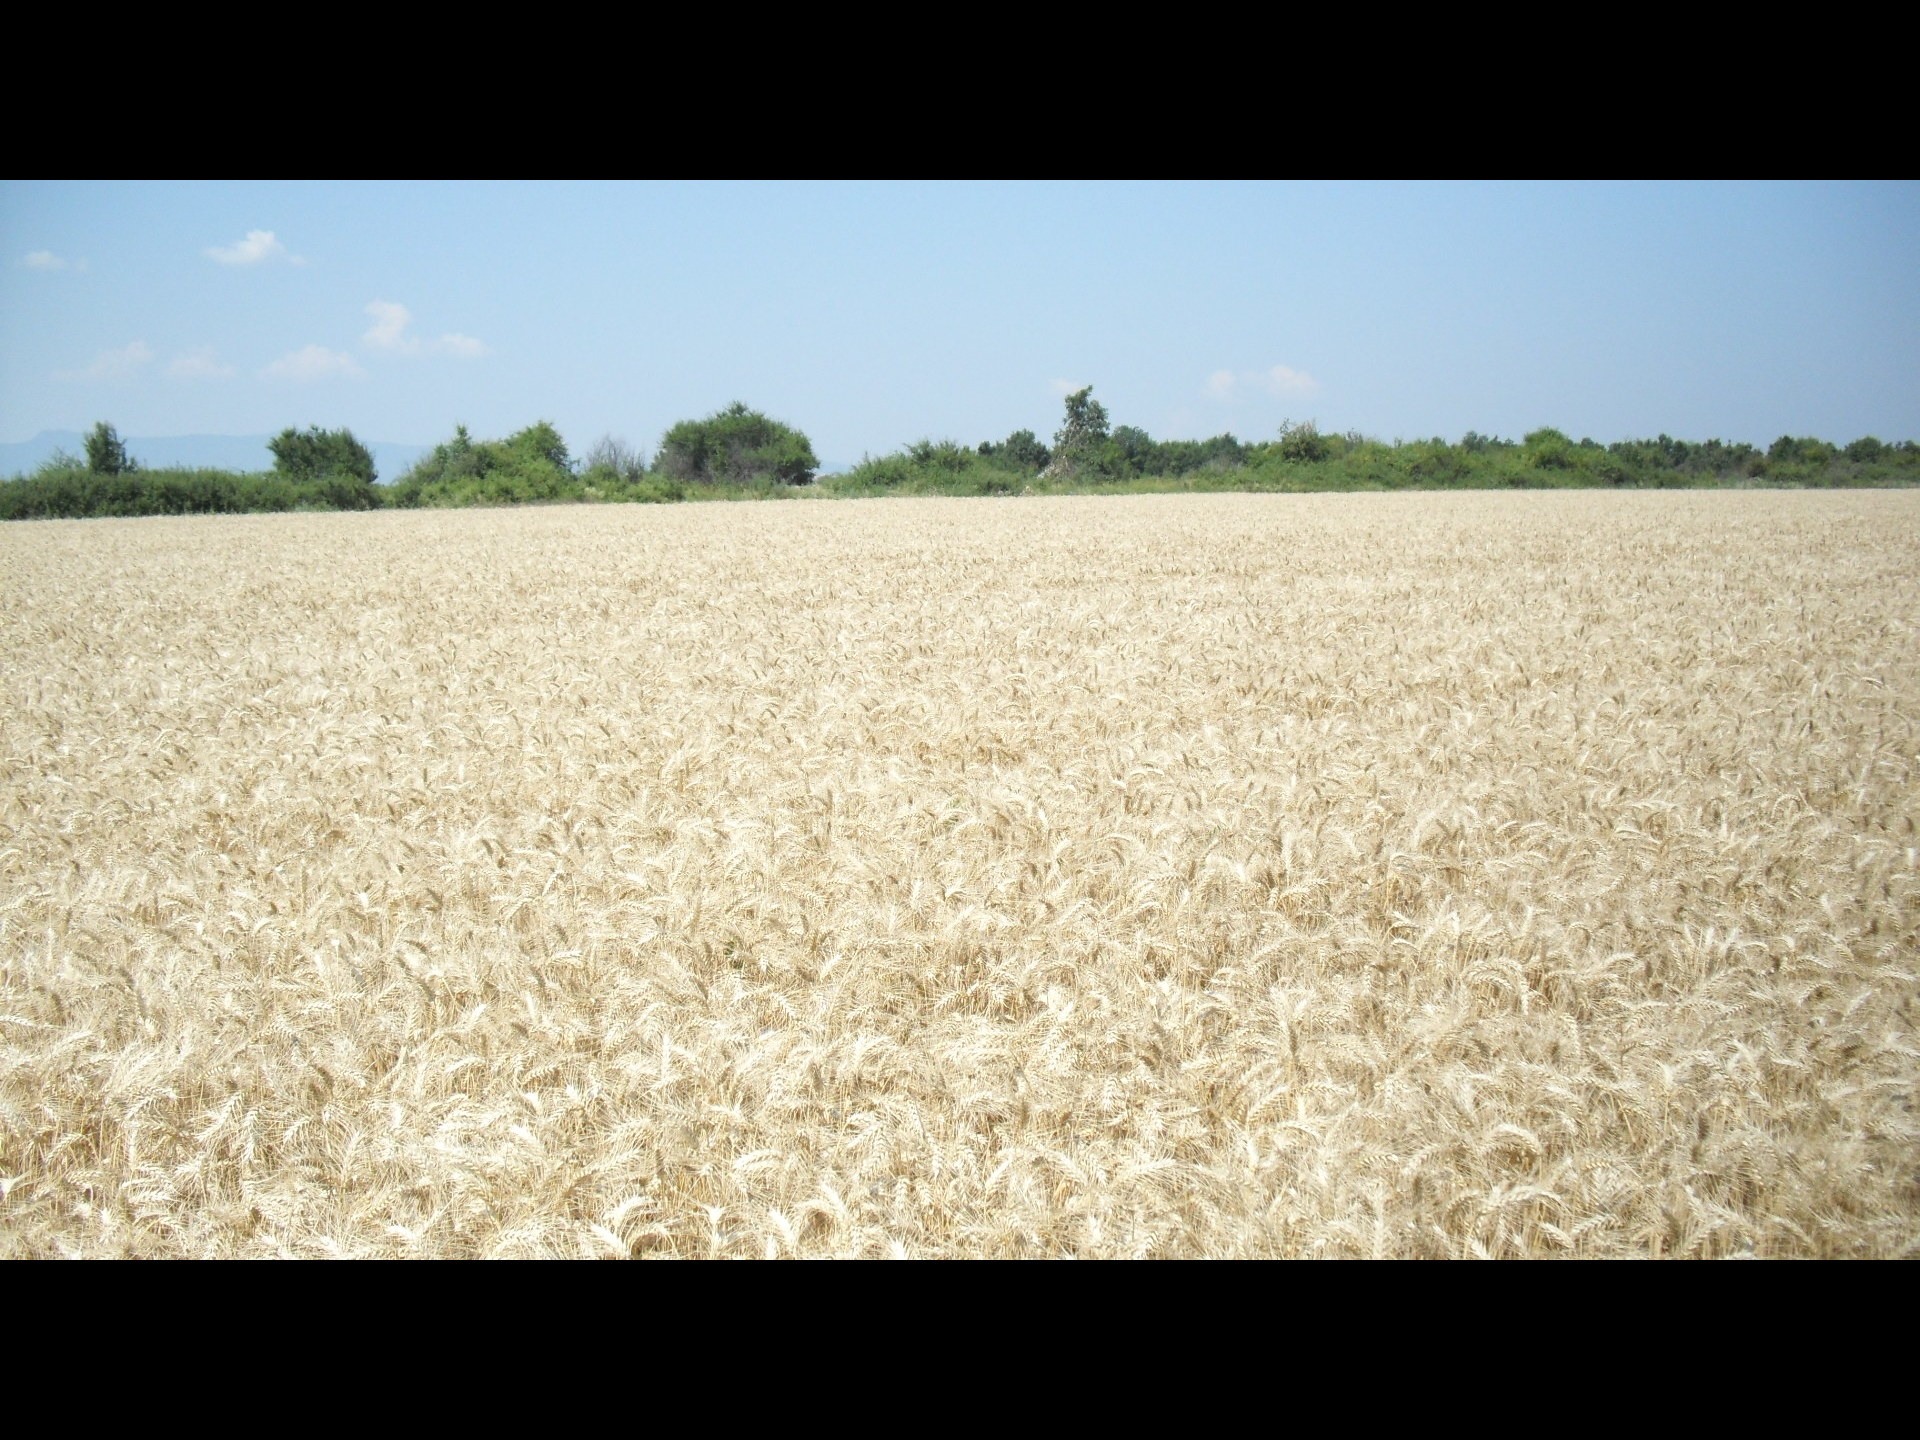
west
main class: Cropland
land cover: Common wheat
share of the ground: > 75 %
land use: Agriculture (excluding fallow land and kitchen gardens)
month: July
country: BG
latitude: 43.6873
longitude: 22.9023
